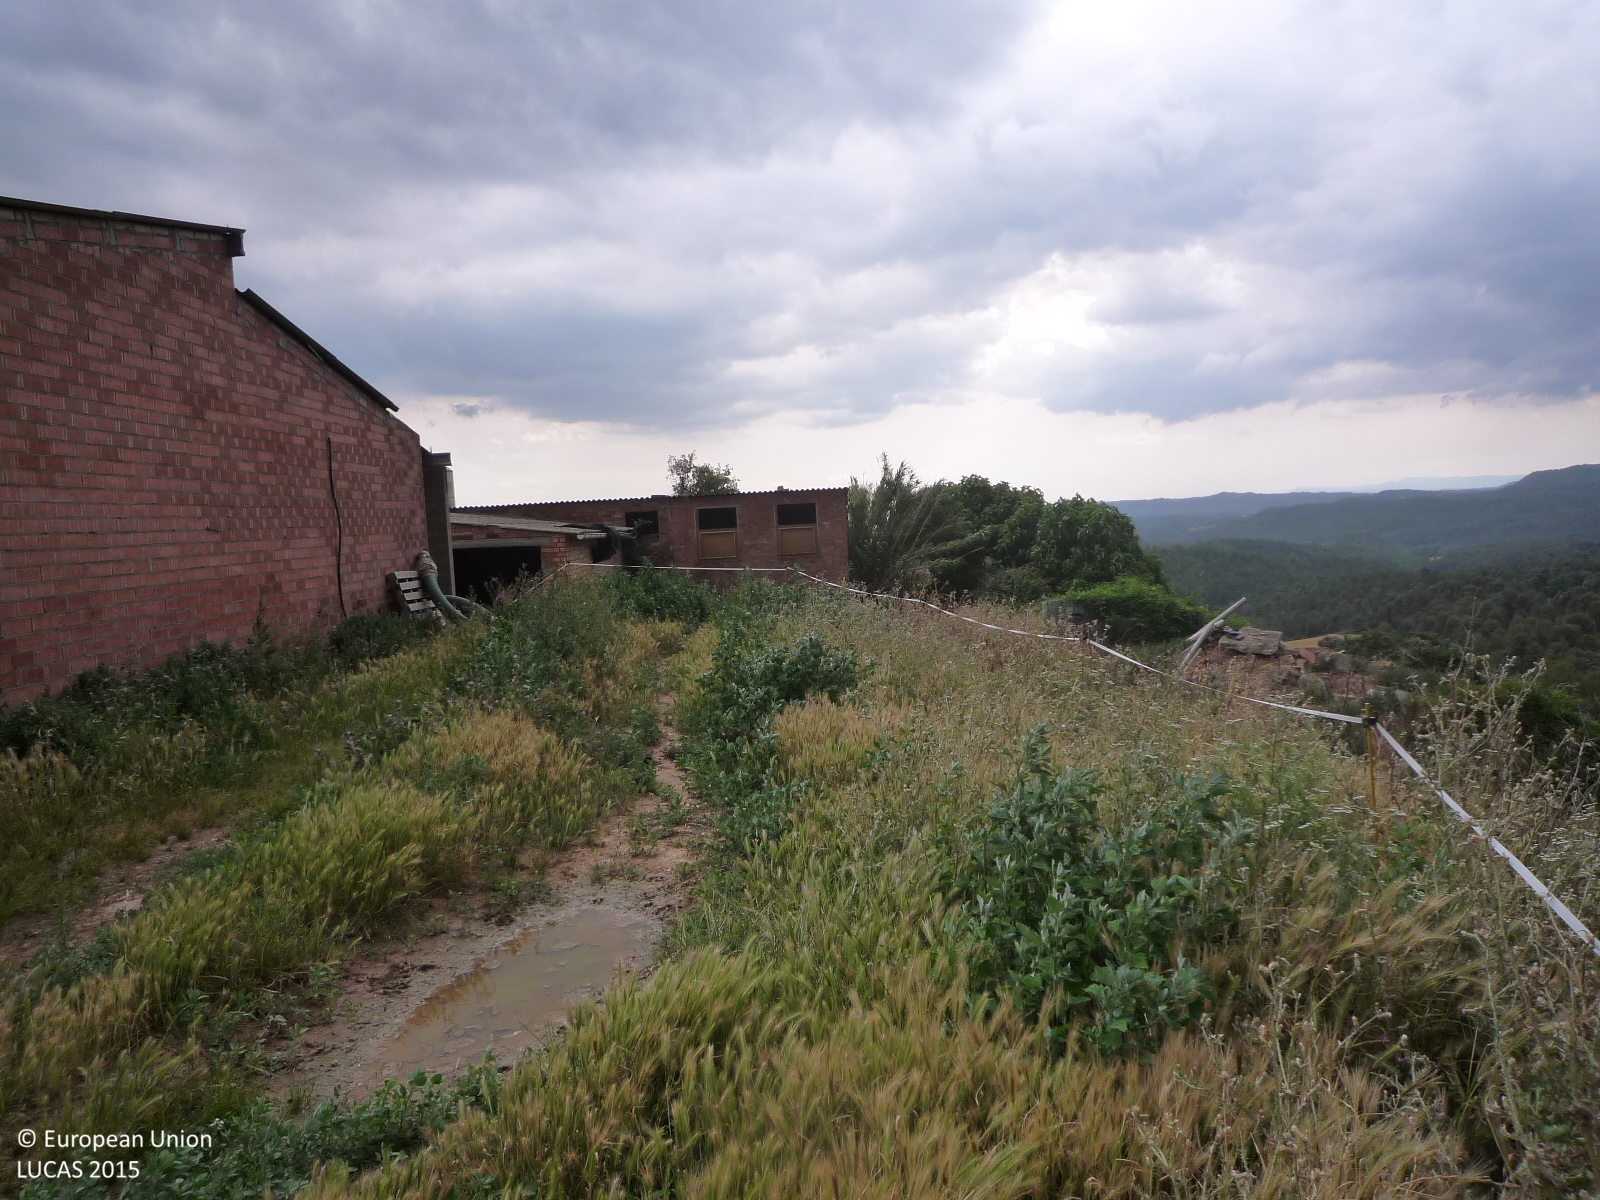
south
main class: Shrubland
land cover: Shrubland with sparse tree cover
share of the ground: > 75 %
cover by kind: shrubs 95 %, broadleaved forest trees 5 %
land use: Semi-natural and natural areas not in use
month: June
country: ES
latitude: 41.9395
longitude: 2.0176
